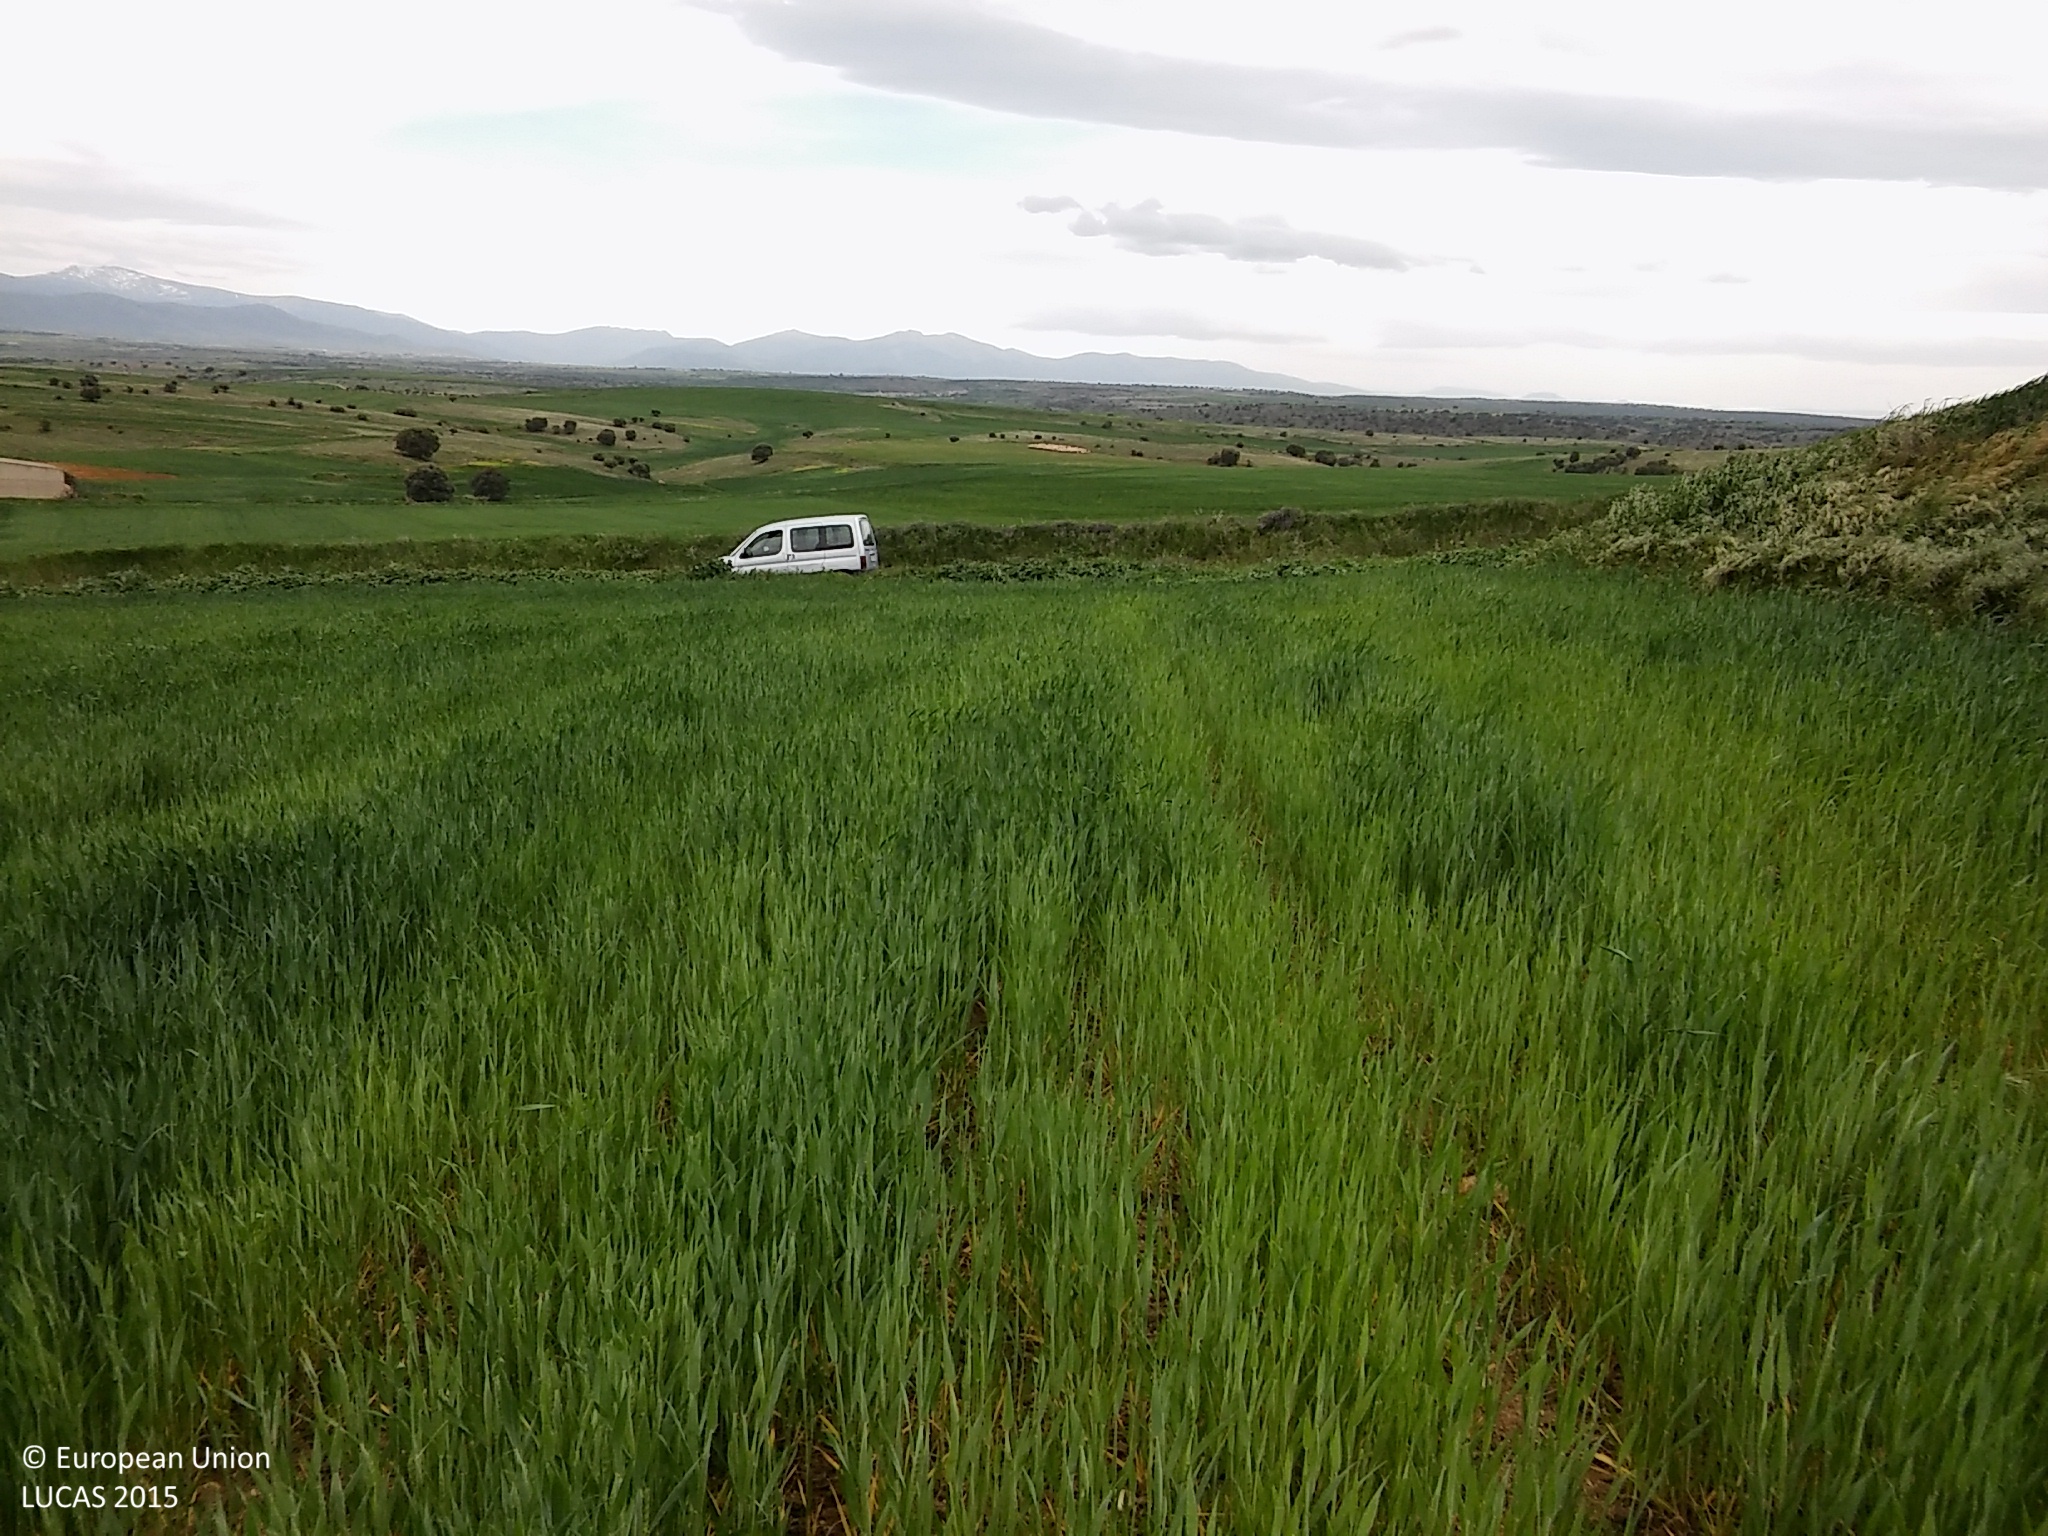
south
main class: Cropland
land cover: Common wheat
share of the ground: > 75 %
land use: Agriculture (excluding fallow land and kitchen gardens)
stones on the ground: < 10 %
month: May
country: ES
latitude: 41.1028
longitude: -4.0418
